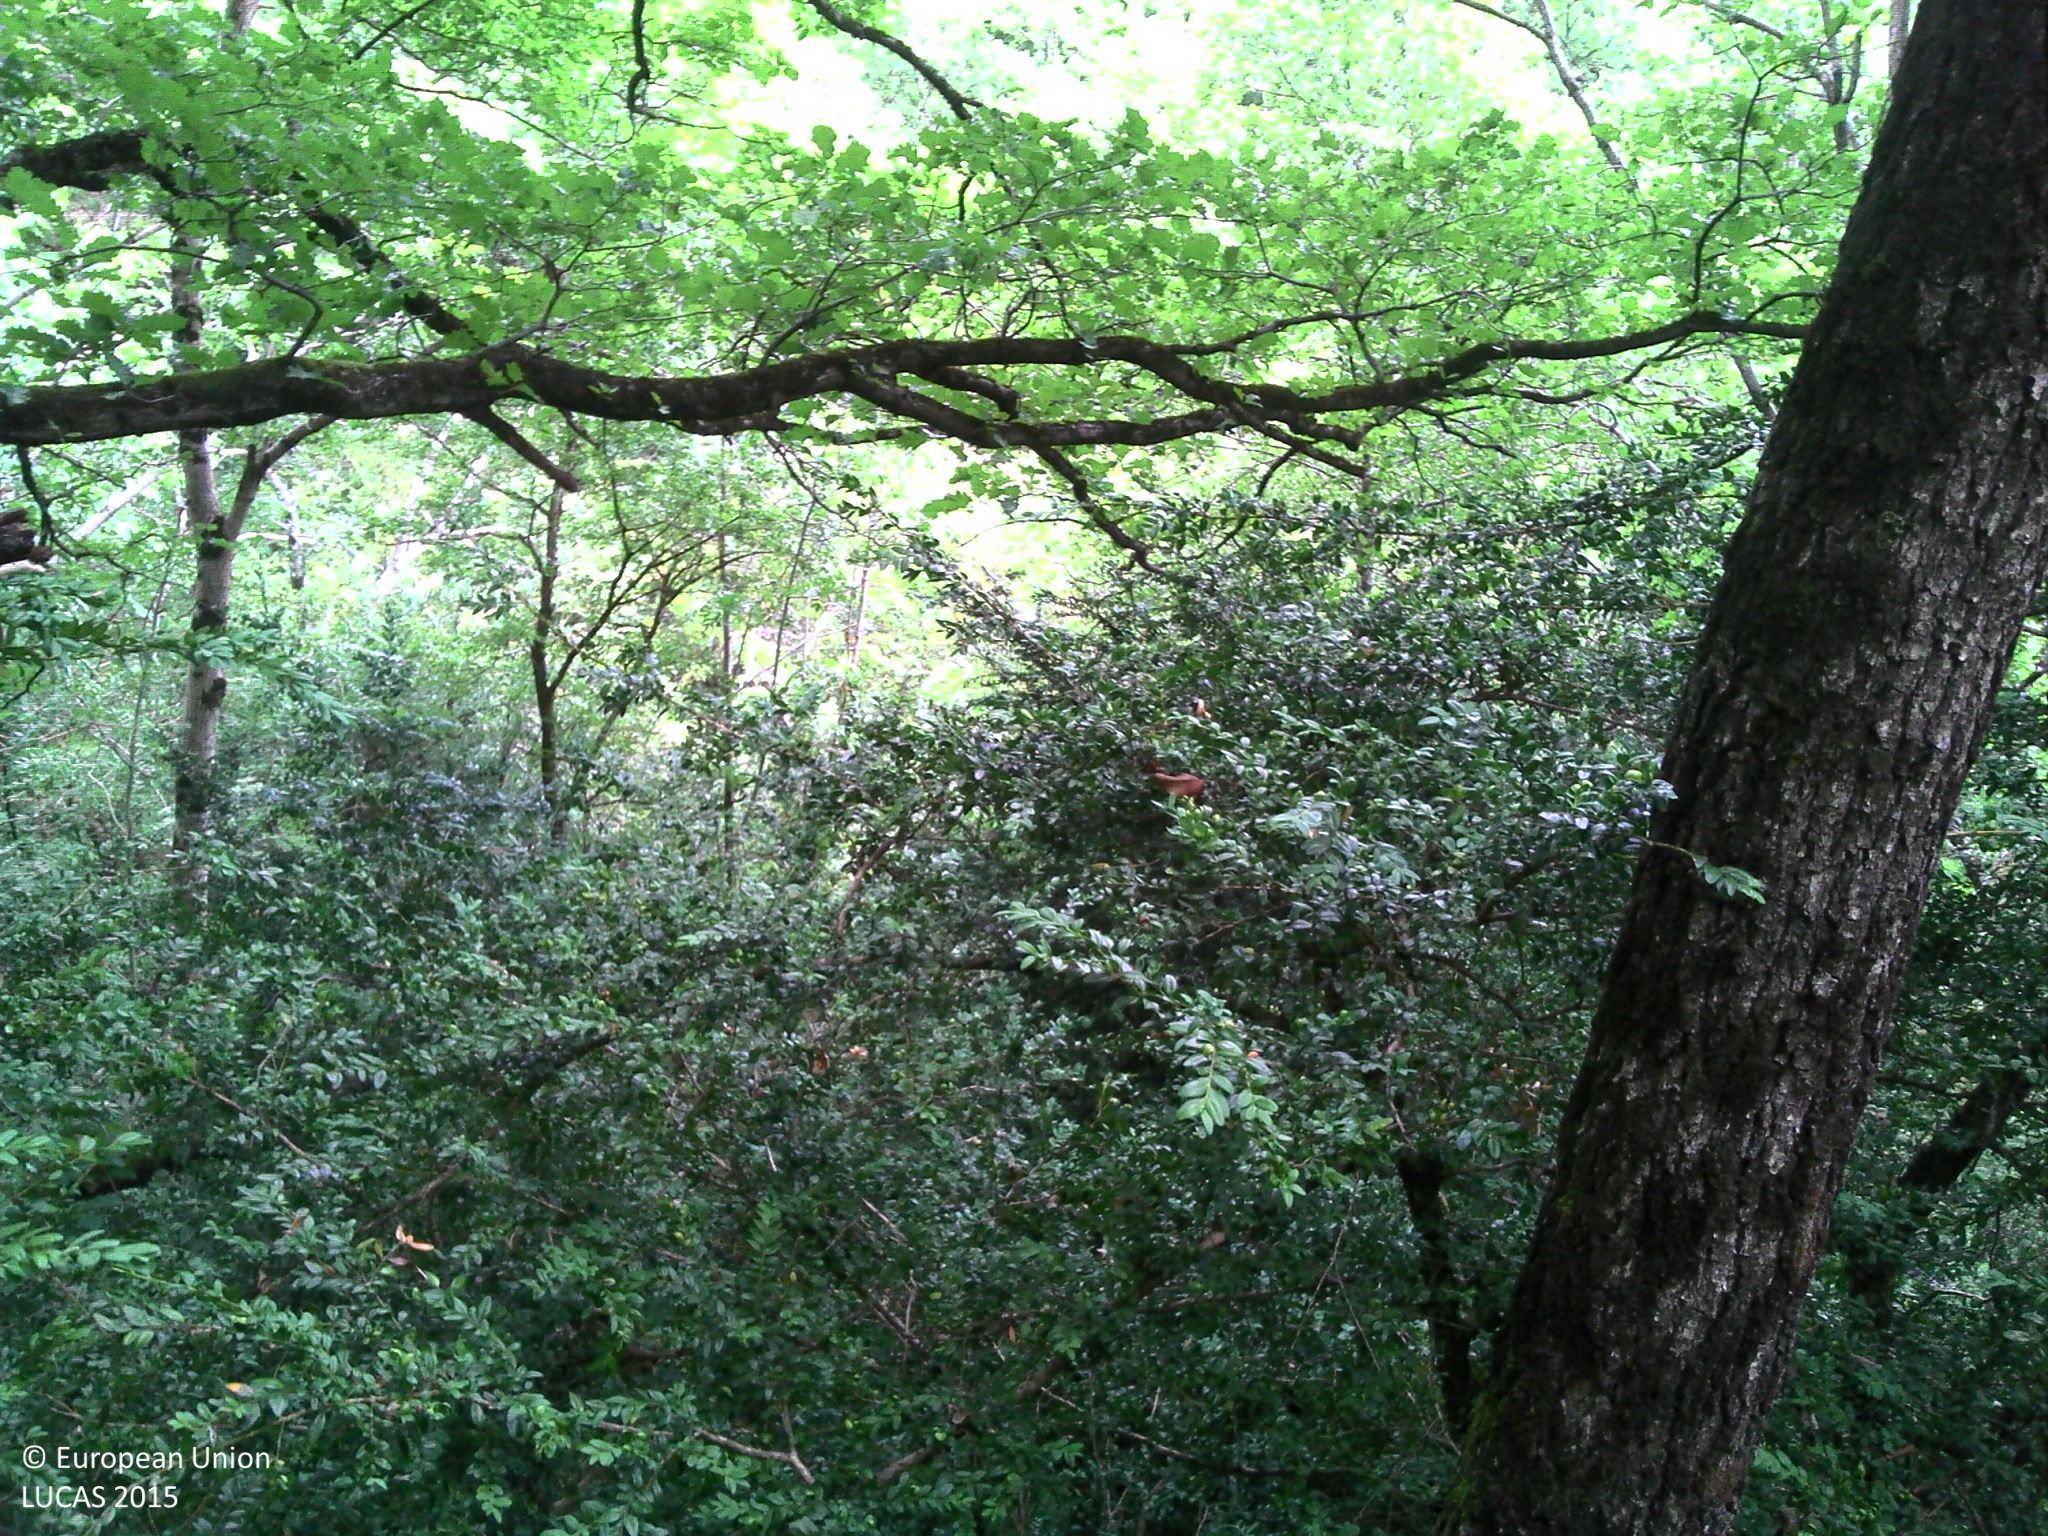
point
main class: Woodland
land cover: Broadleaved woodland
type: broadleaved evergreen forest
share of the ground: > 75 %
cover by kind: broadleaved forest trees 100 %
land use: Semi-natural and natural areas not in use
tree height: > 5 m
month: July
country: FR
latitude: 44.7527
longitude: 4.6123
